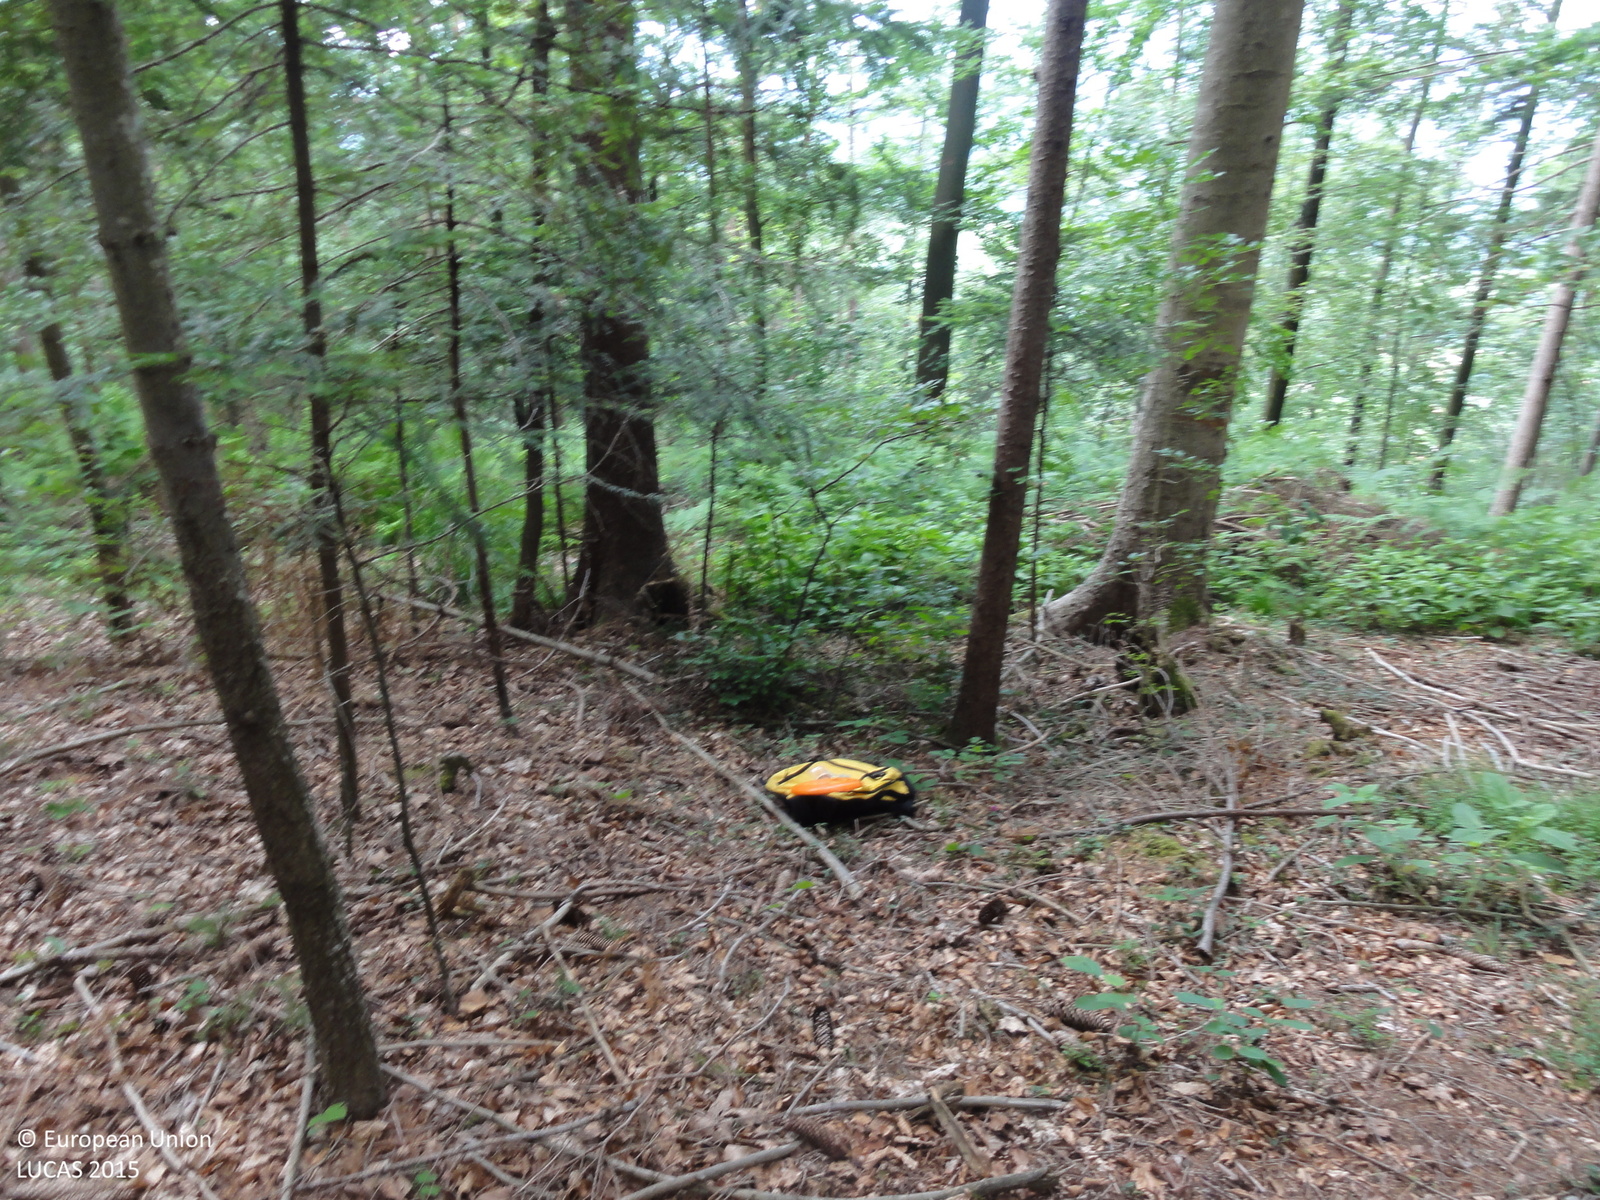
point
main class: Woodland
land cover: Spruce dominated mixed woodland
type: mountainous beech forest
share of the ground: > 75 %
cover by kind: coniferous forest trees 65 %, broadleaved forest trees 30 %, shrubs 5 %
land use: Forestry
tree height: > 5 m
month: June
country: SI
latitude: 46.3306
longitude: 14.8686
